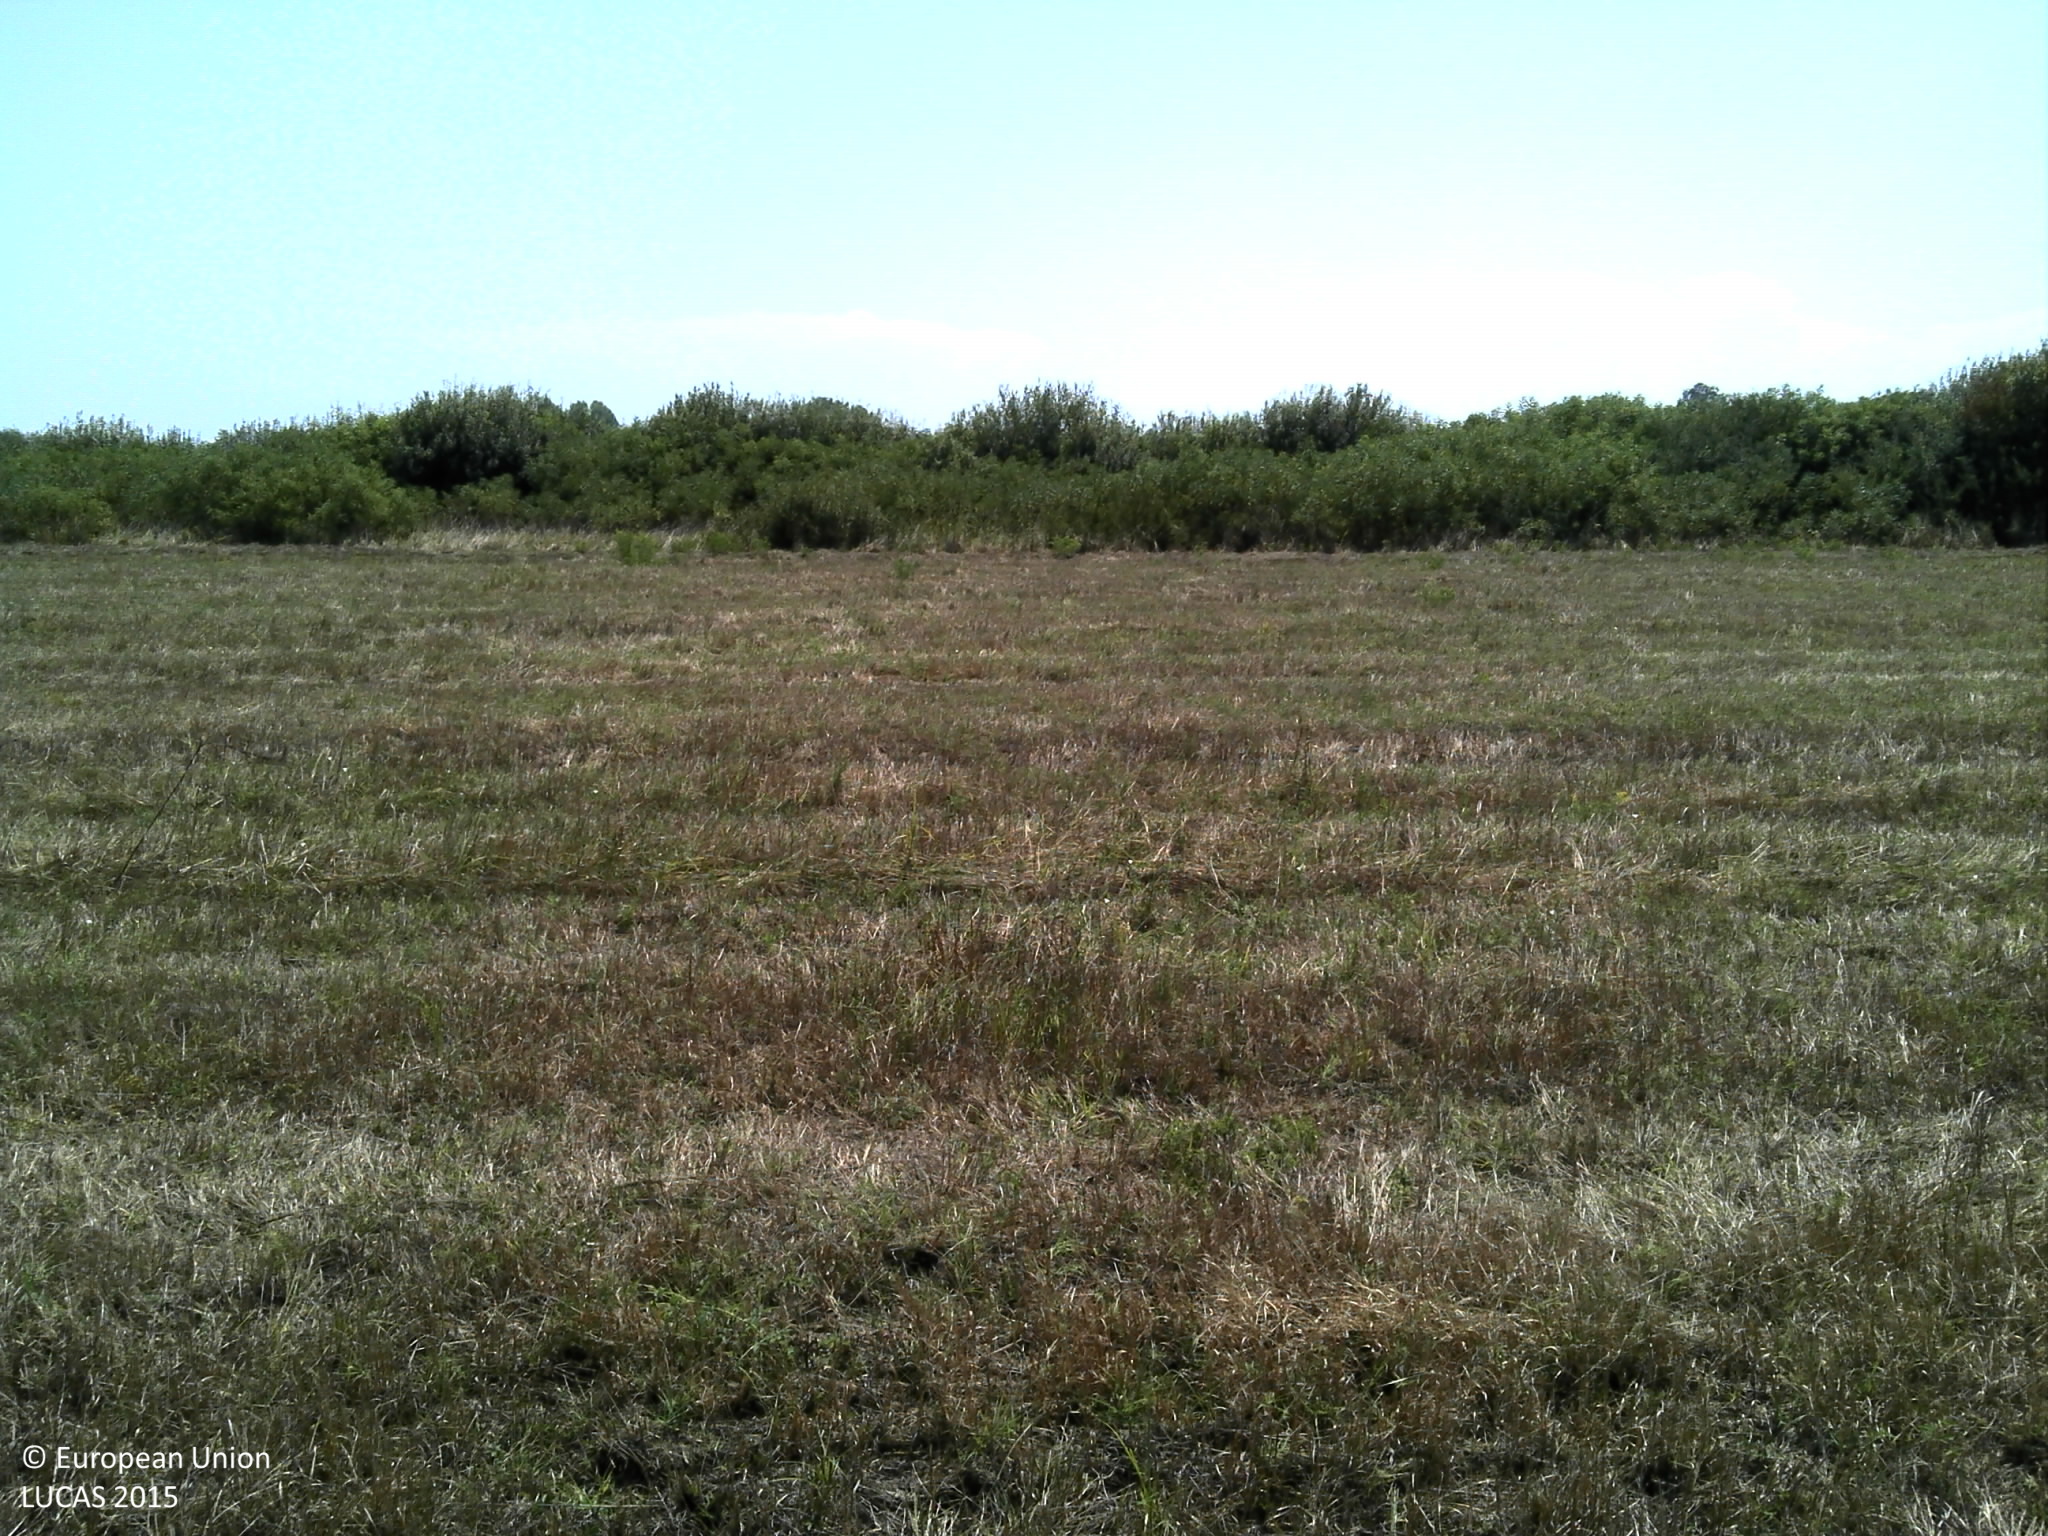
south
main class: Grassland
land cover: Grassland without tree/shrub cover
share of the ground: > 75 %
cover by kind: herbaceous plants 100 %
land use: Agriculture (excluding fallow land and kitchen gardens)
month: August
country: HR
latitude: 45.4950
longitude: 16.3320
